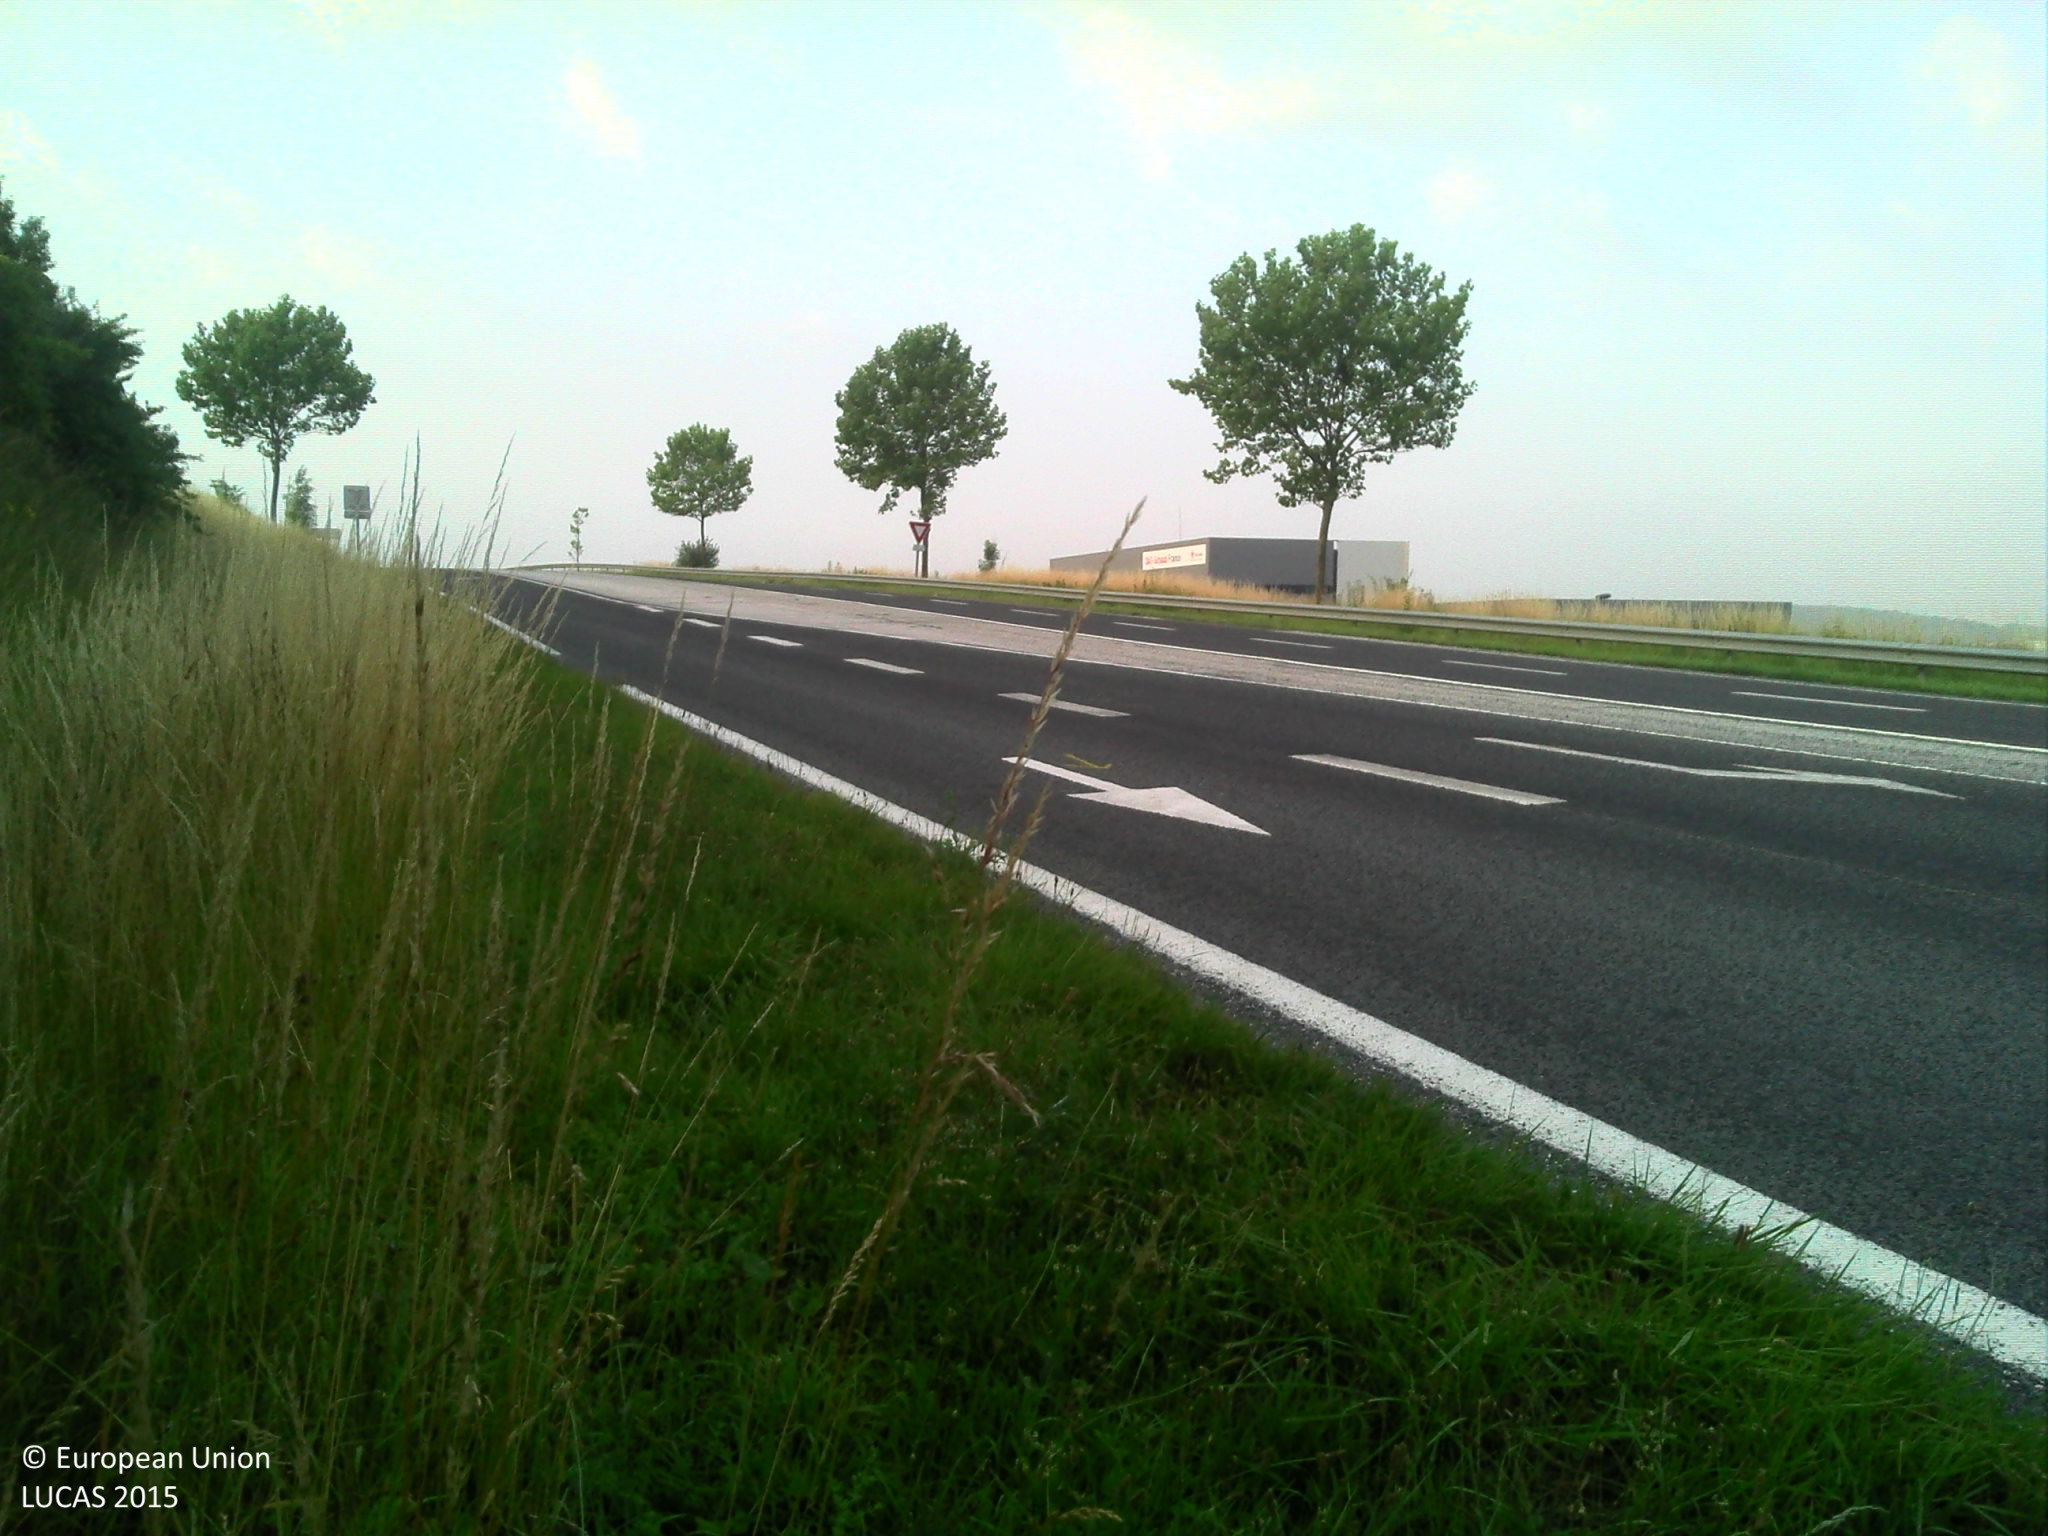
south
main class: Cropland
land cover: Common wheat
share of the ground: > 75 %
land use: Agriculture (excluding fallow land and kitchen gardens)
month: July
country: FR
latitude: 49.7908
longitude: 2.4727
